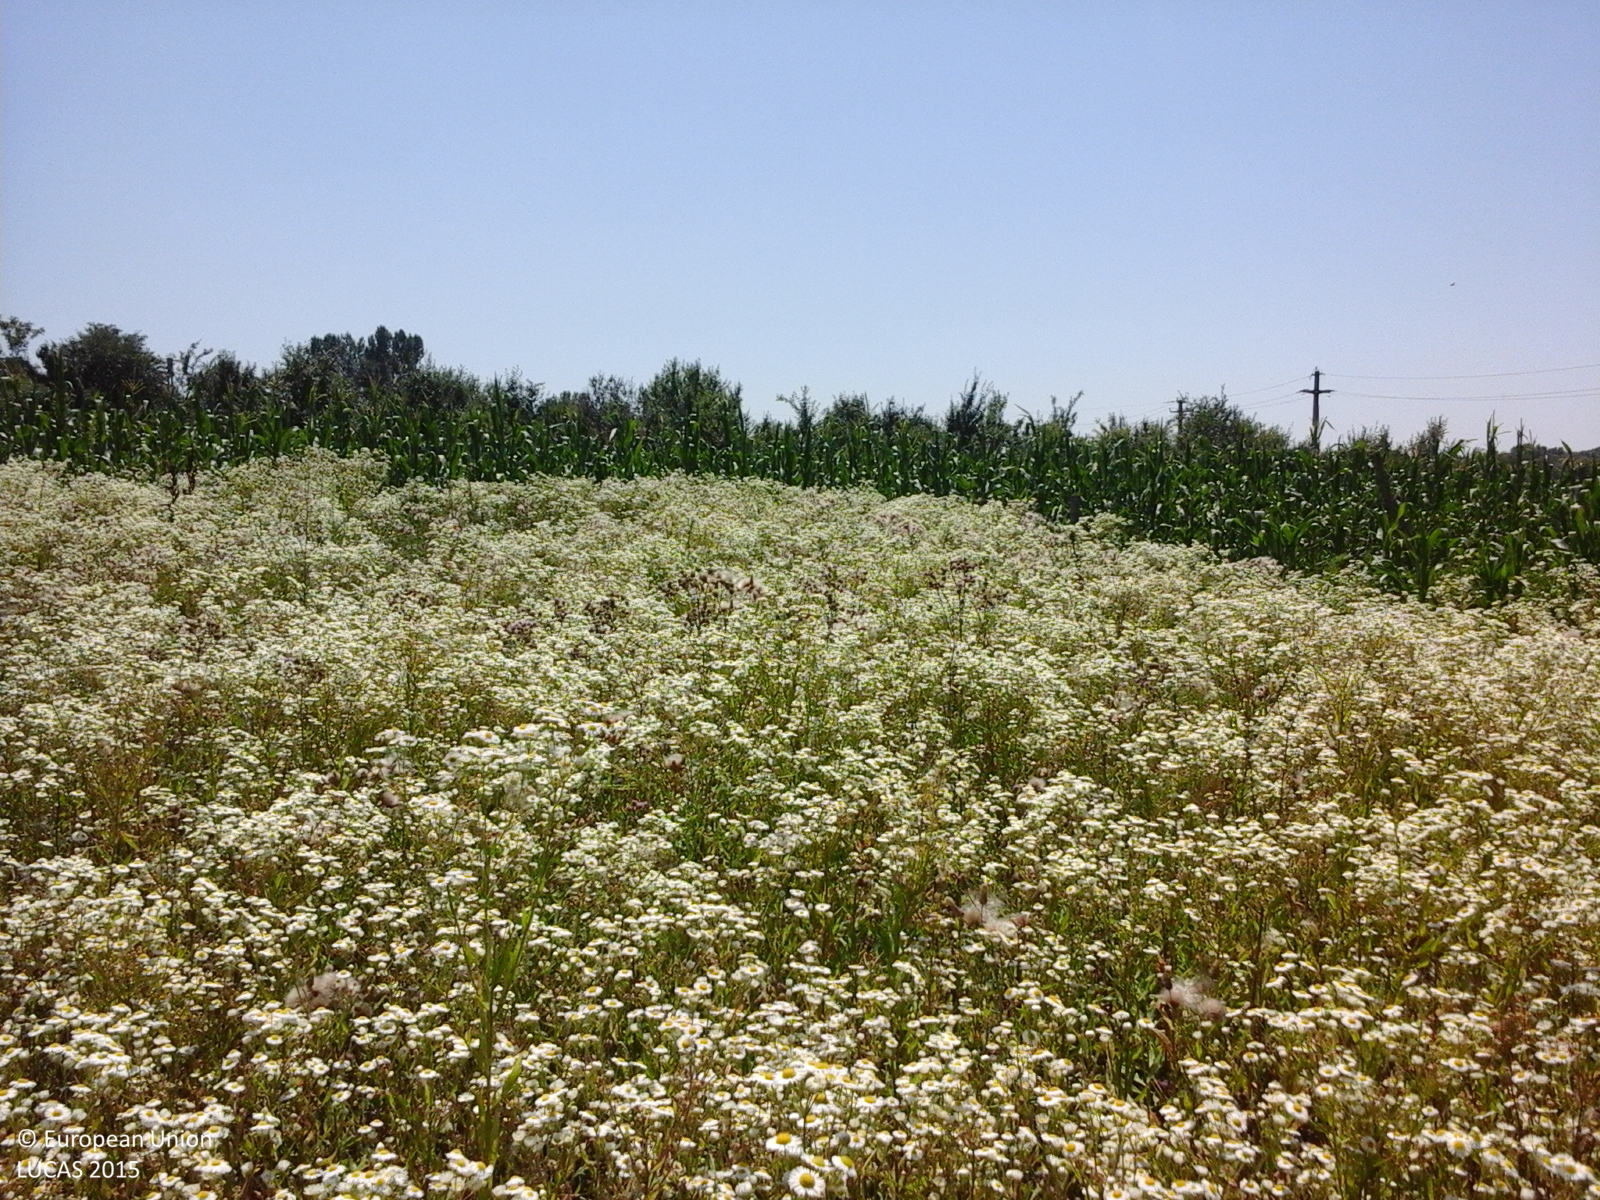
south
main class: Grassland
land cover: Spontaneously vegetated surfaces
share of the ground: > 75 %
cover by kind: herbaceous plants 100 %
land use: Agriculture (excluding fallow land and kitchen gardens)
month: July
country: RO
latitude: 44.6419
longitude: 24.3796
